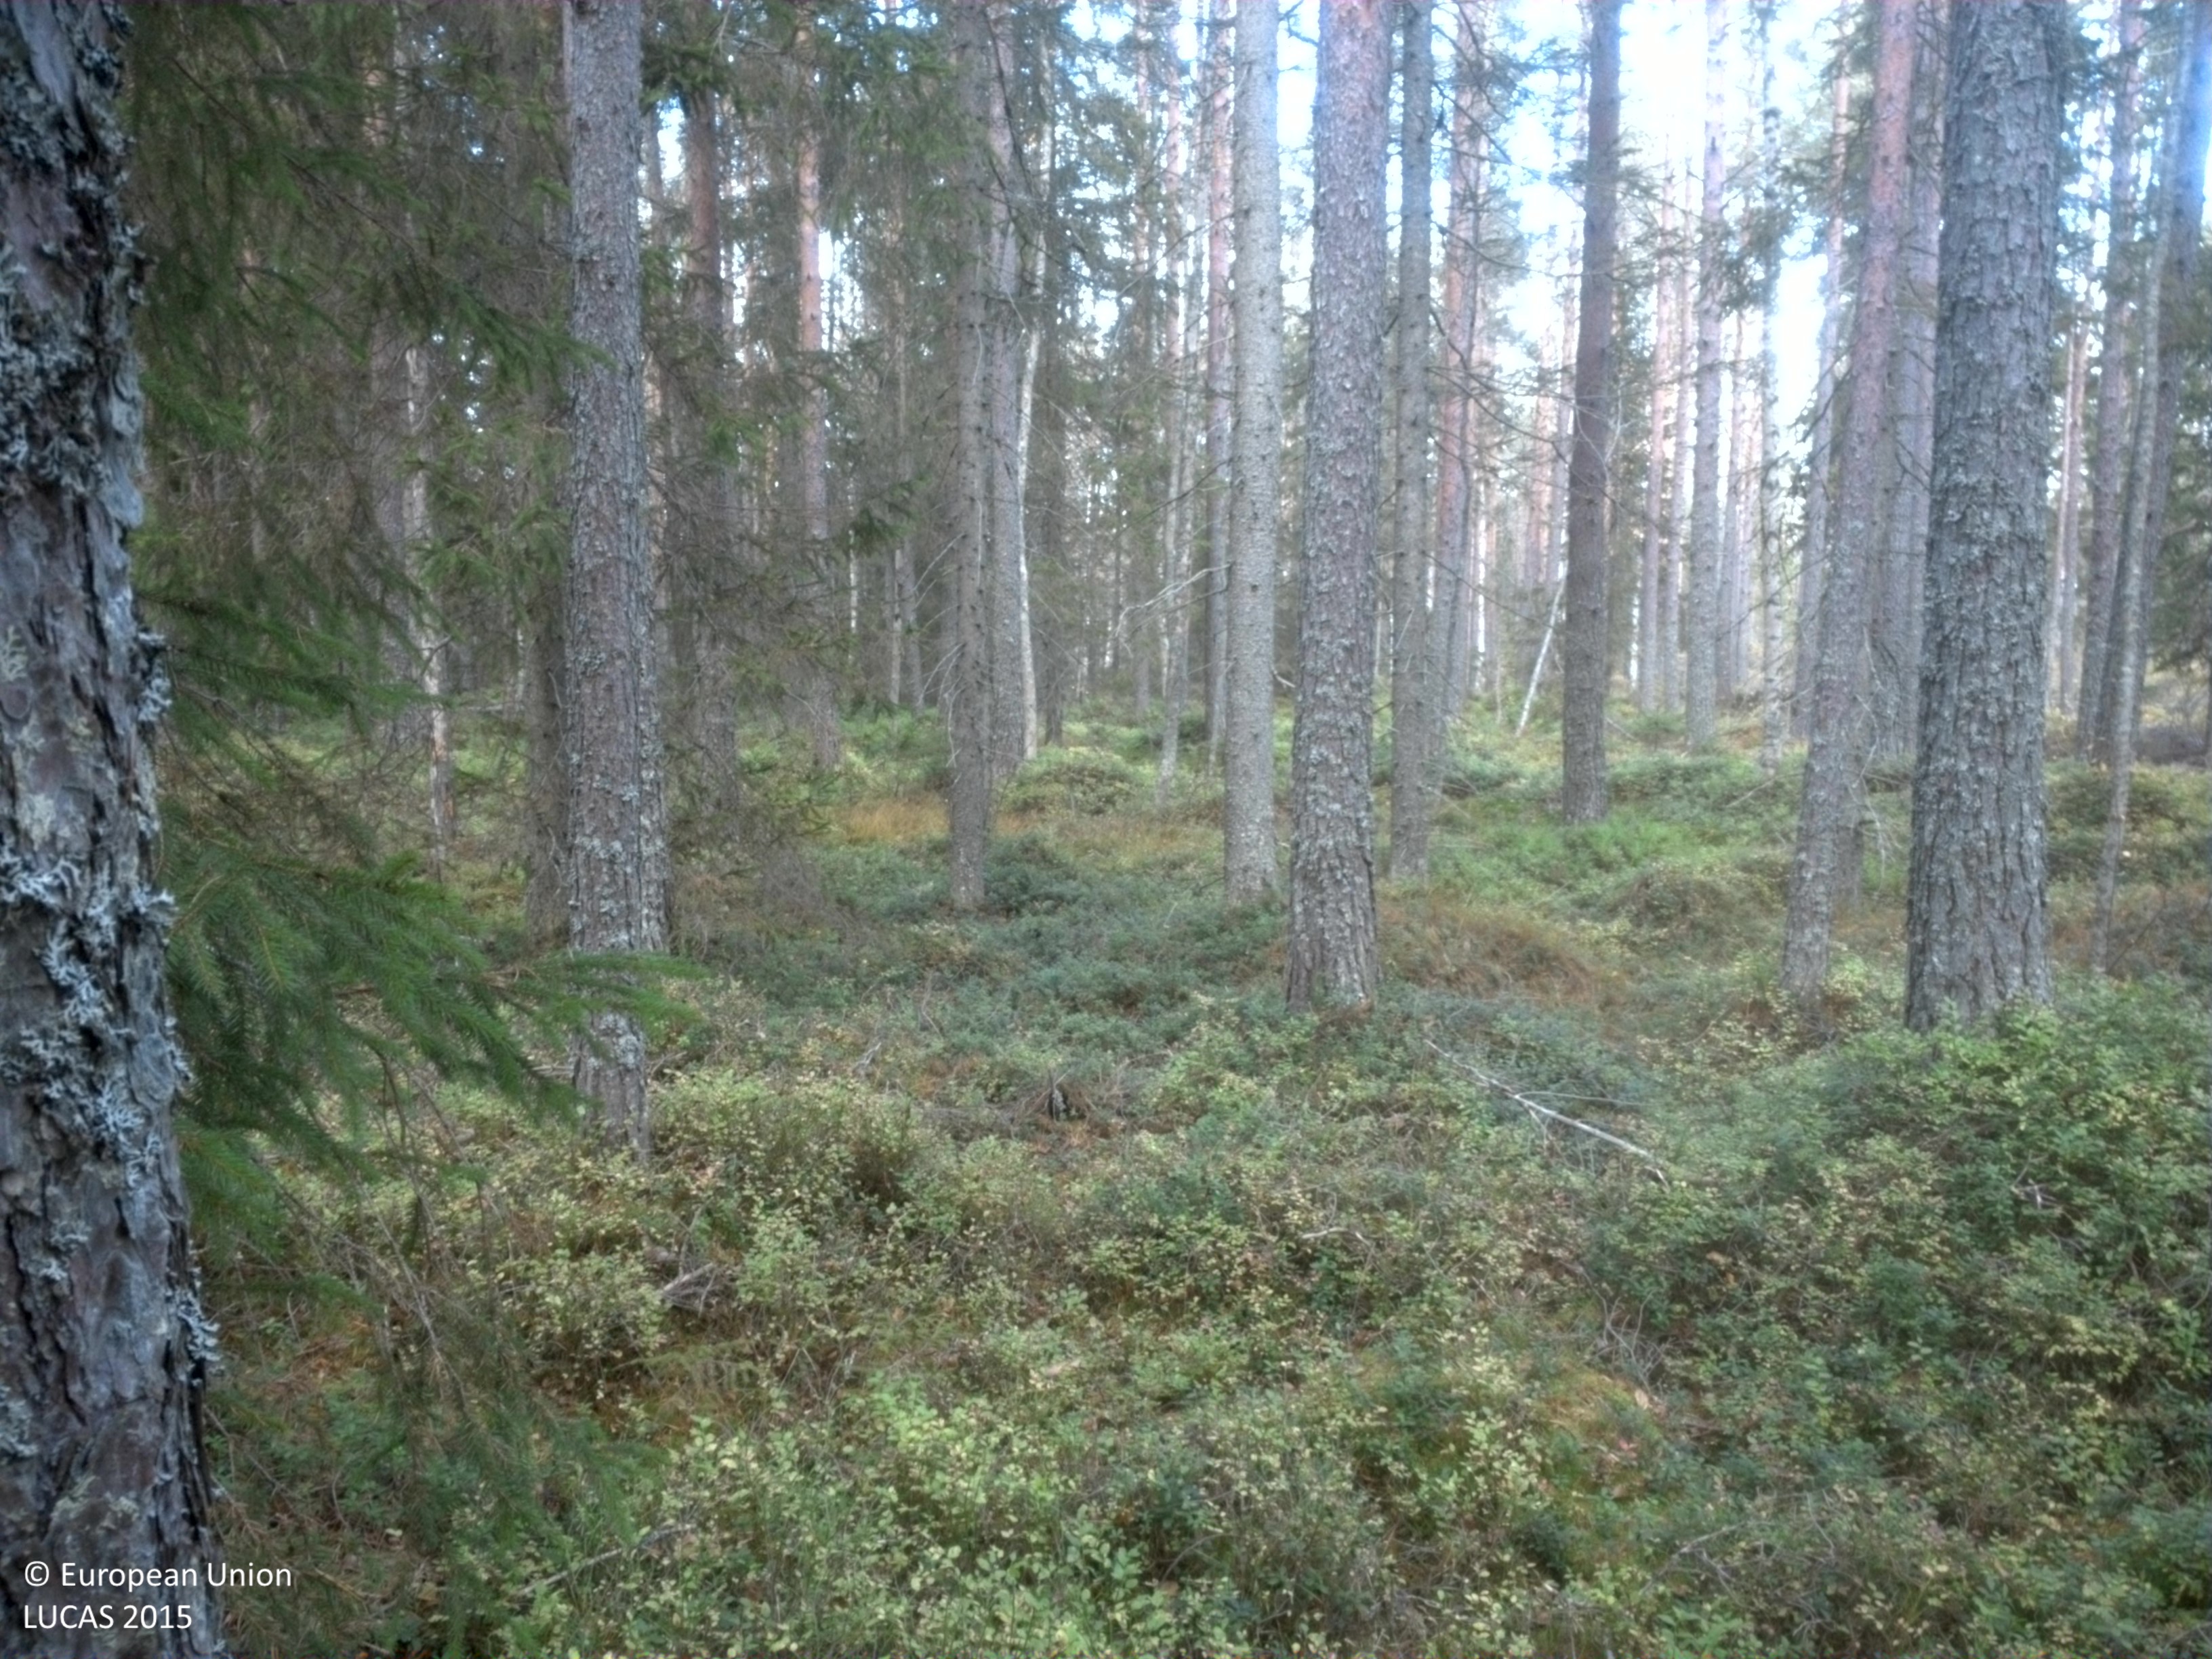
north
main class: Woodland
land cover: Other mixed woodland
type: boreal forest
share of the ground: 50 - 75 %
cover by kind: coniferous forest trees 45 %, shrubs 35 %, broadleaved forest trees 20 %
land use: Forestry
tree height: > 5 m
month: October
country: SE
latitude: 63.9953
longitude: 20.7570
